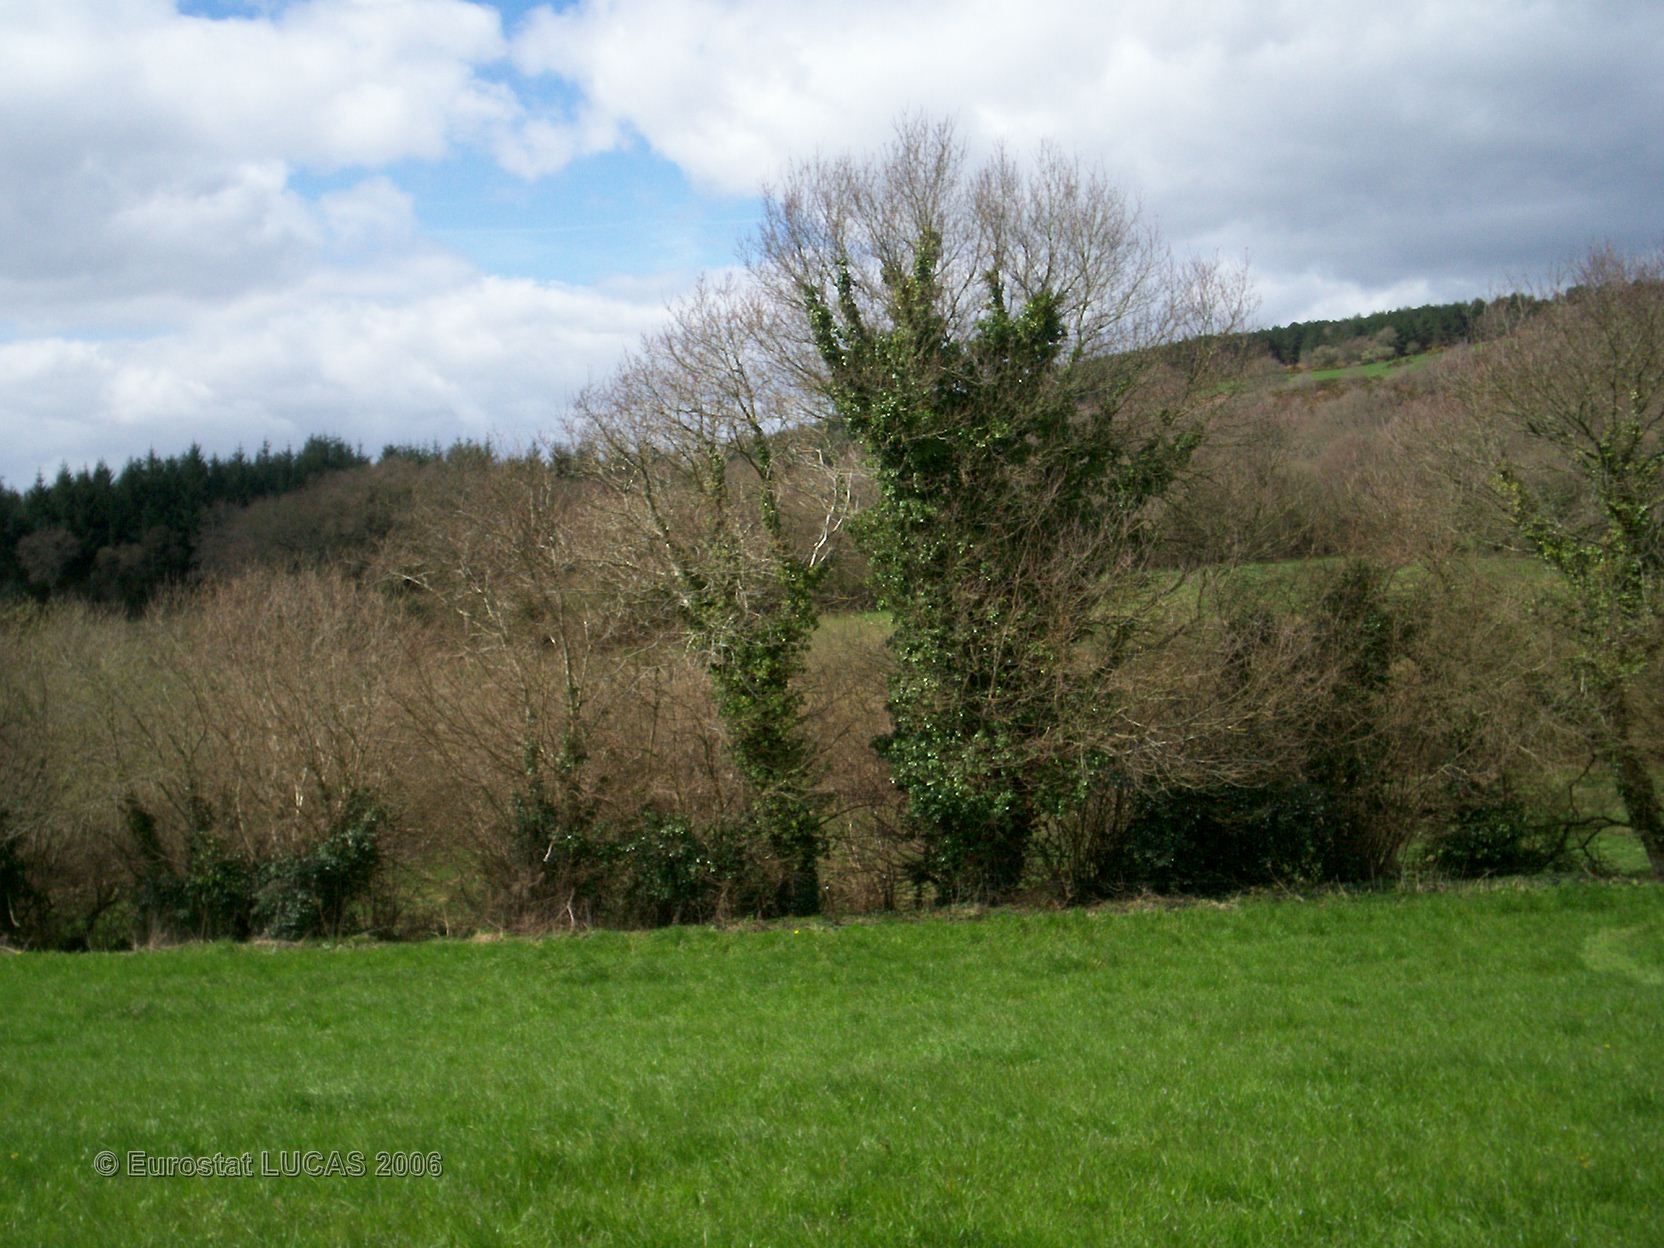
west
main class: Grassland
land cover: Grassland without tree/shrub cover
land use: Agriculture (excluding fallow land and kitchen gardens)
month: April
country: FR
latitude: 48.0987
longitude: -3.6559
